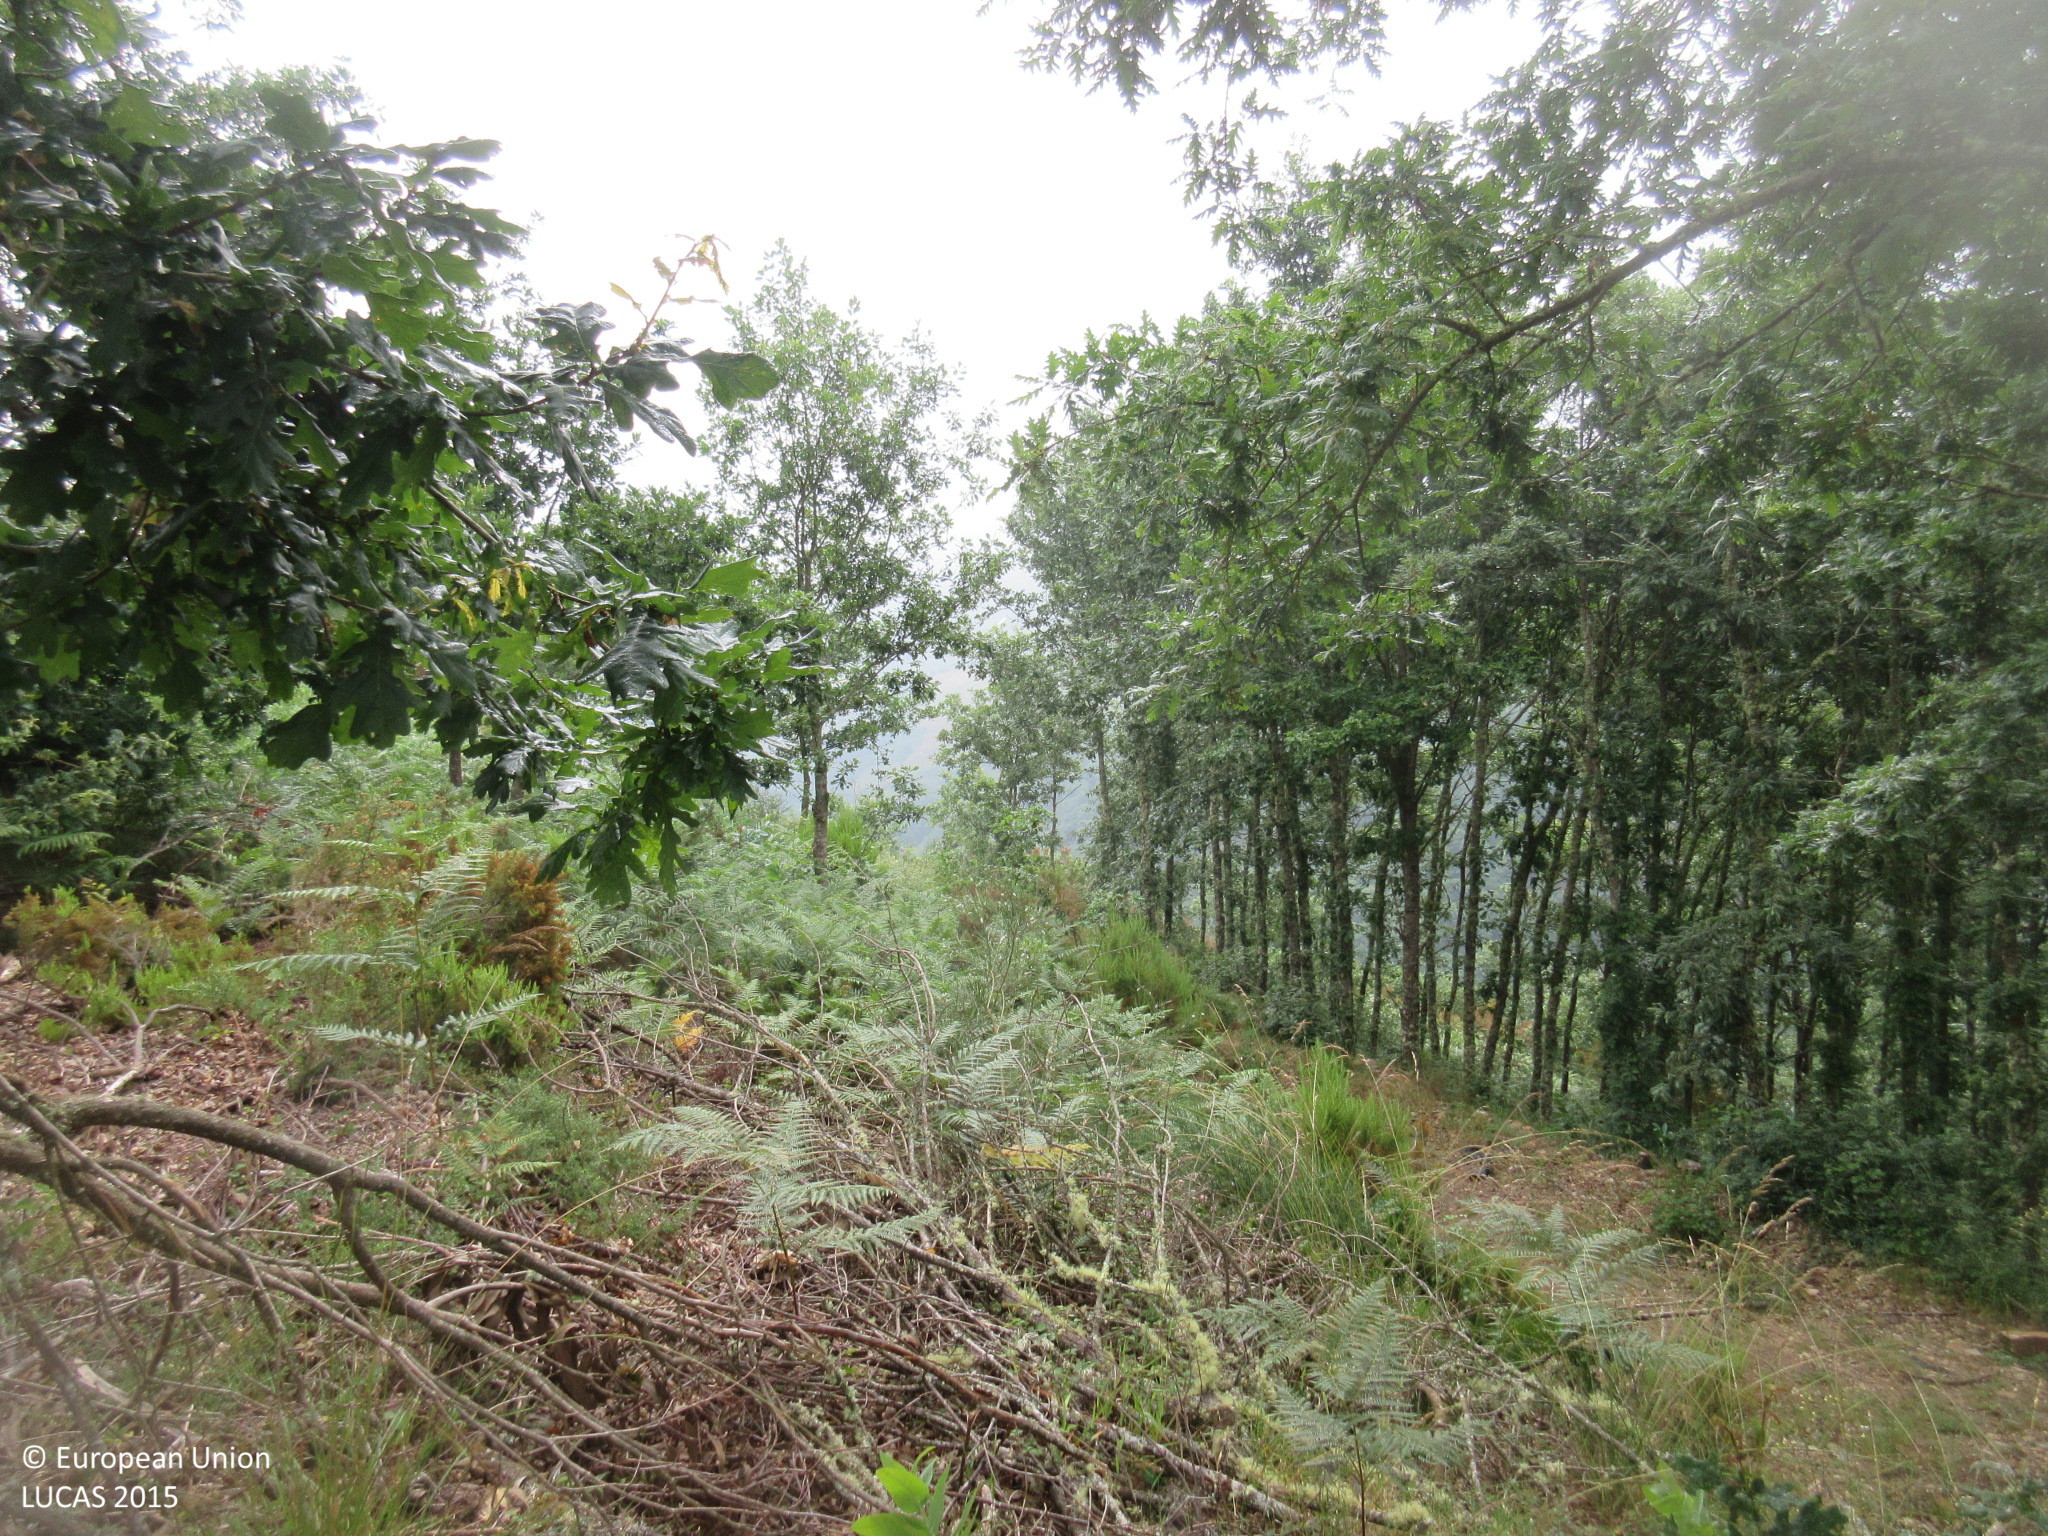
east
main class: Woodland
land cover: Broadleaved woodland
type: acidophilous oak and oak-birch forest
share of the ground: > 75 %
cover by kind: broadleaved forest trees 90 %, shrubs 10 %
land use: Forestry
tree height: > 5 m
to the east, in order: Broadleaved woodland; Tracks; Broadleaved woodland; Tracks; Broadleaved woodland
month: June
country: ES
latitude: 42.9660
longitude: -7.1436
